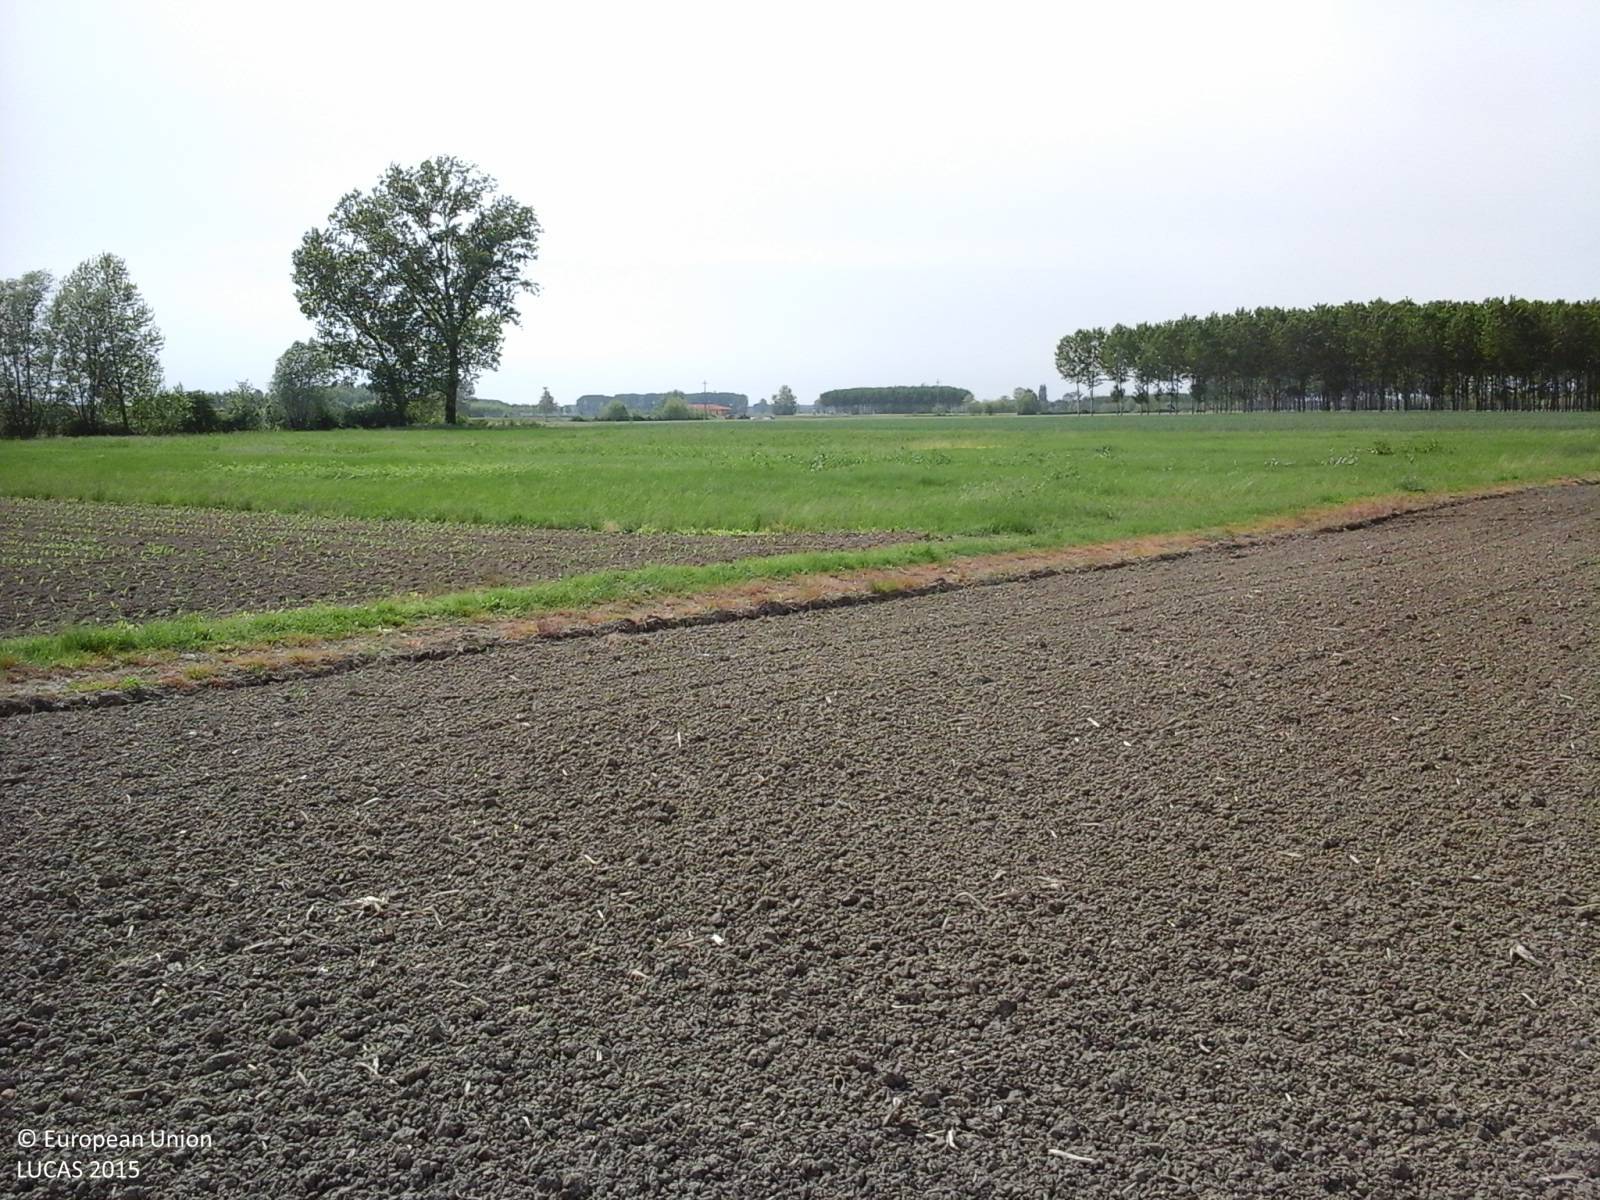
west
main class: Cropland
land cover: Soya
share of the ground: < 10 %
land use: Agriculture (excluding fallow land and kitchen gardens)
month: May
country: IT
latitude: 45.8391
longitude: 13.0476
